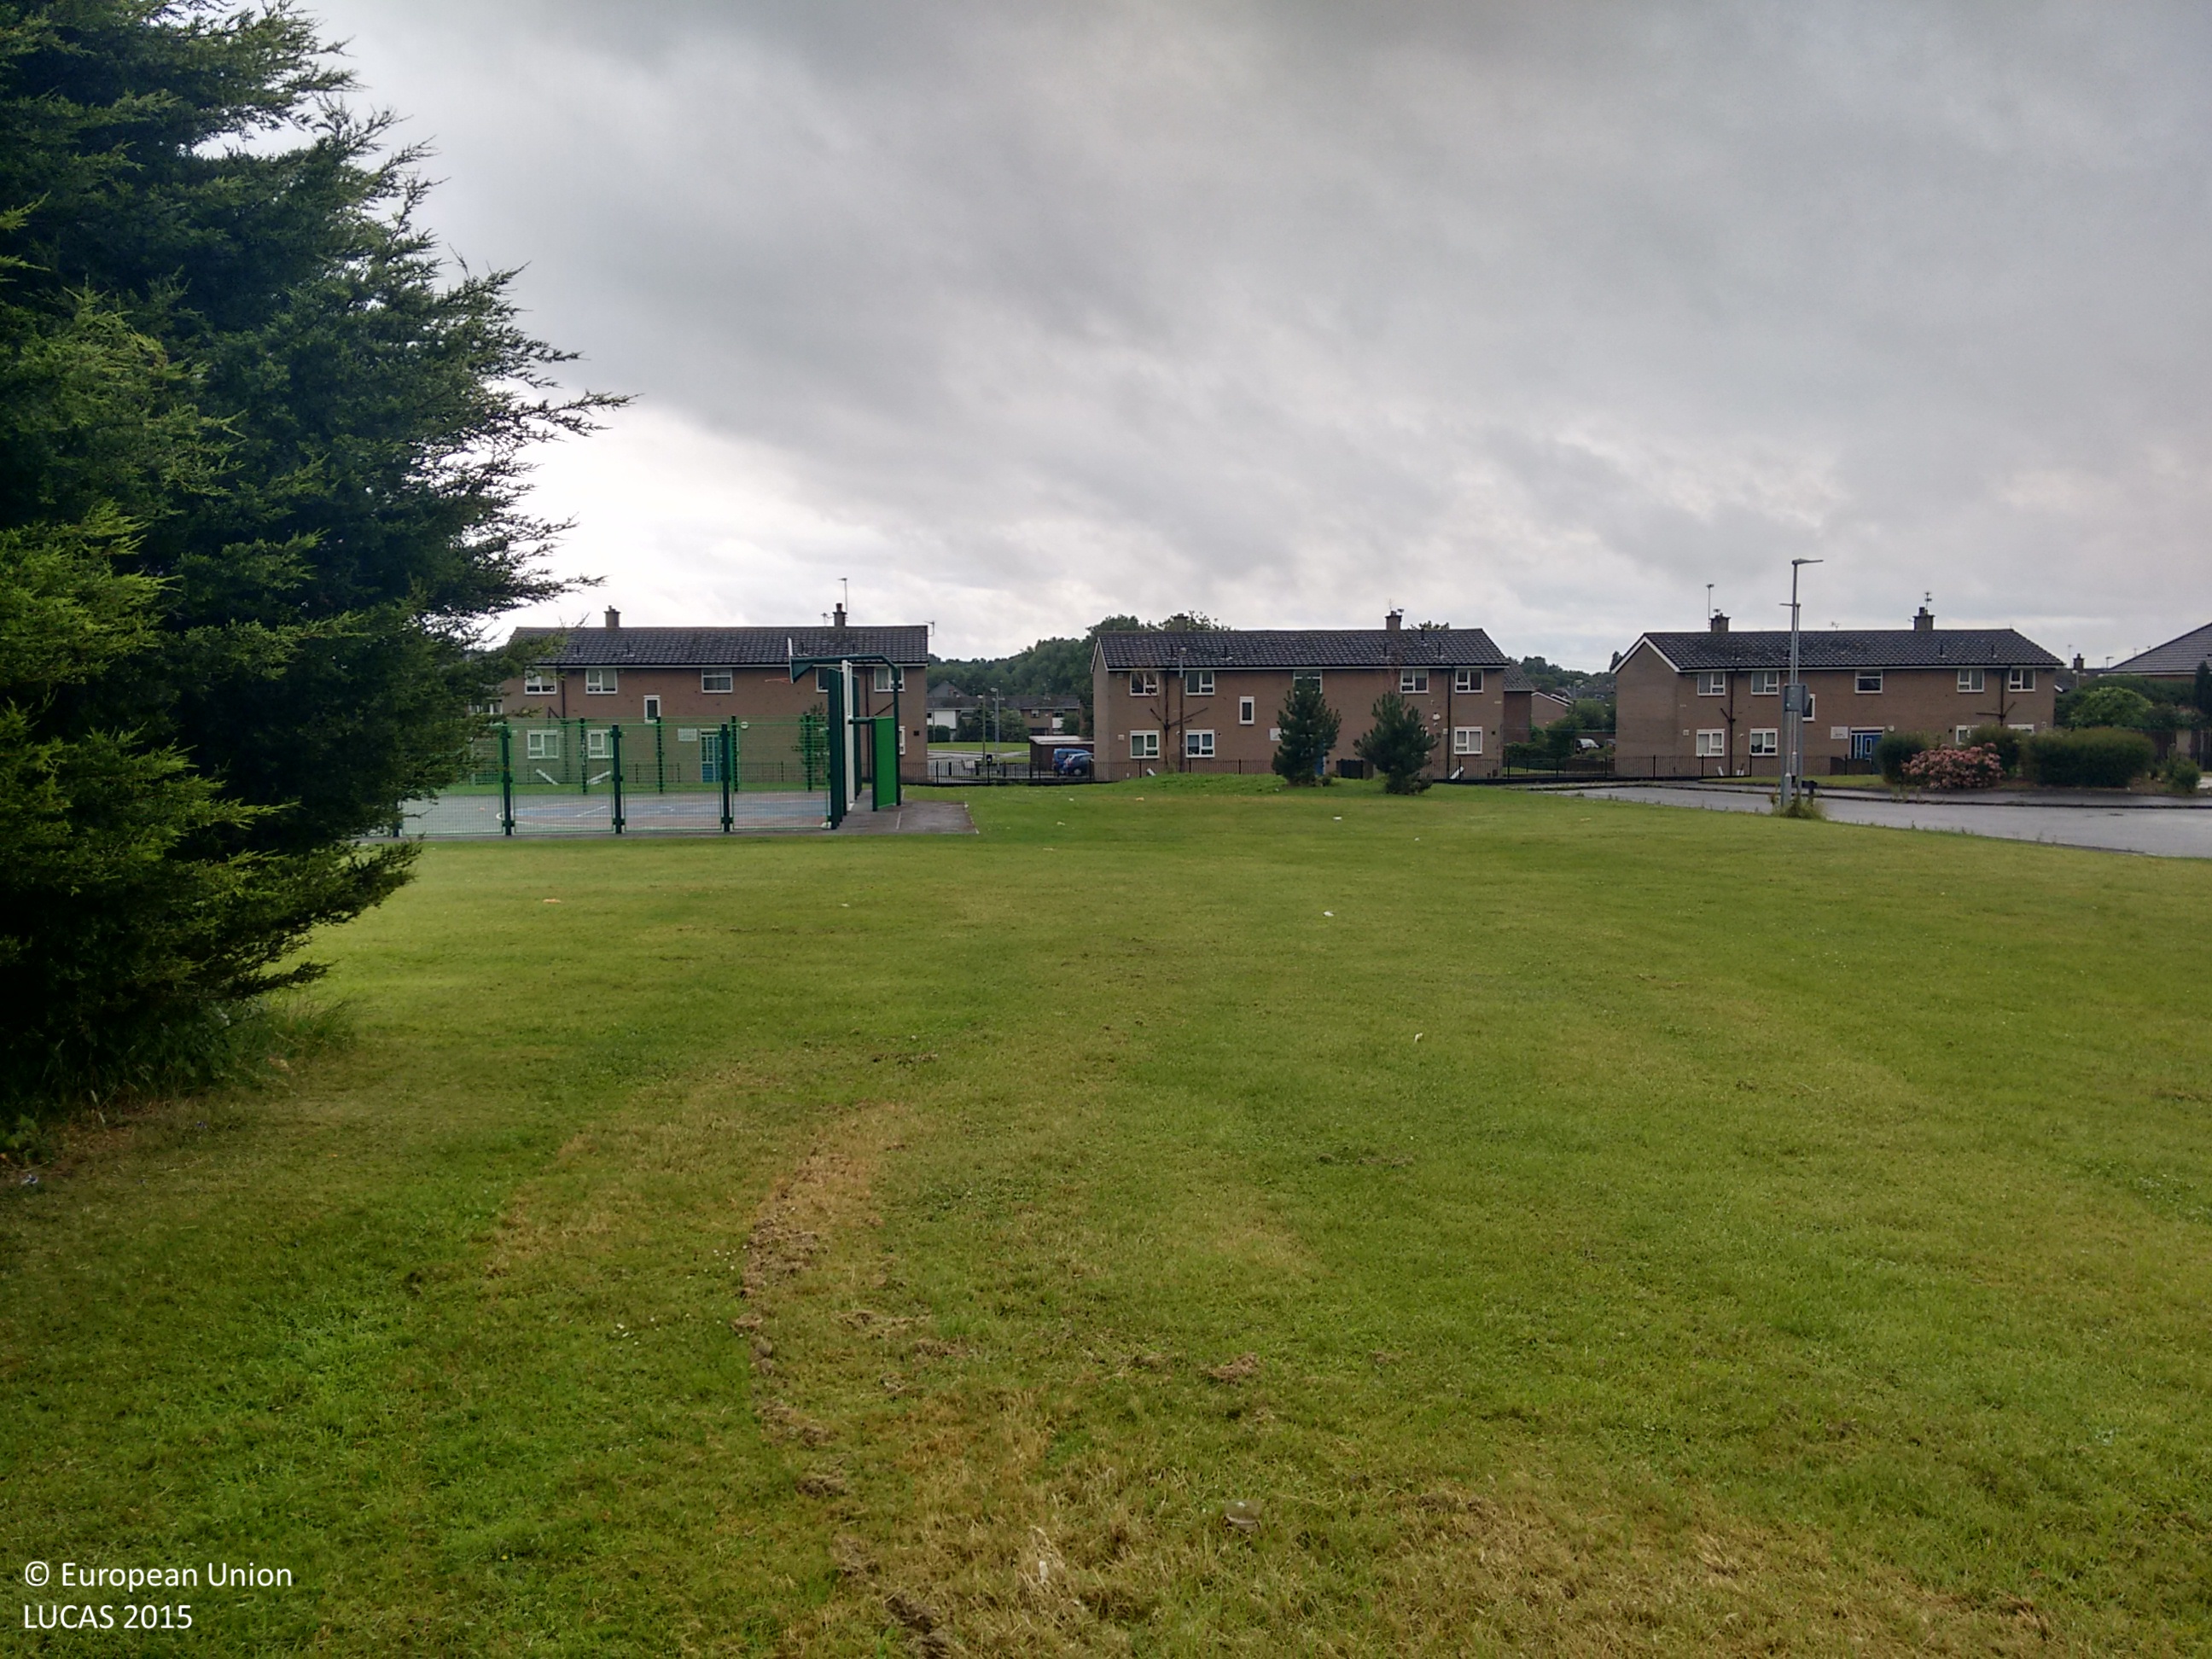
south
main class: Grassland
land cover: Grassland with sparse tree/shrub cover
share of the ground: > 75 %
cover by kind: herbaceous plants 95 %, broadleaved forest trees 5 %
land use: Amenities, museums, leisure
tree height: > 5 m
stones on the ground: < 10 %
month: July
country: GB
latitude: 53.3777
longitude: -2.7725
